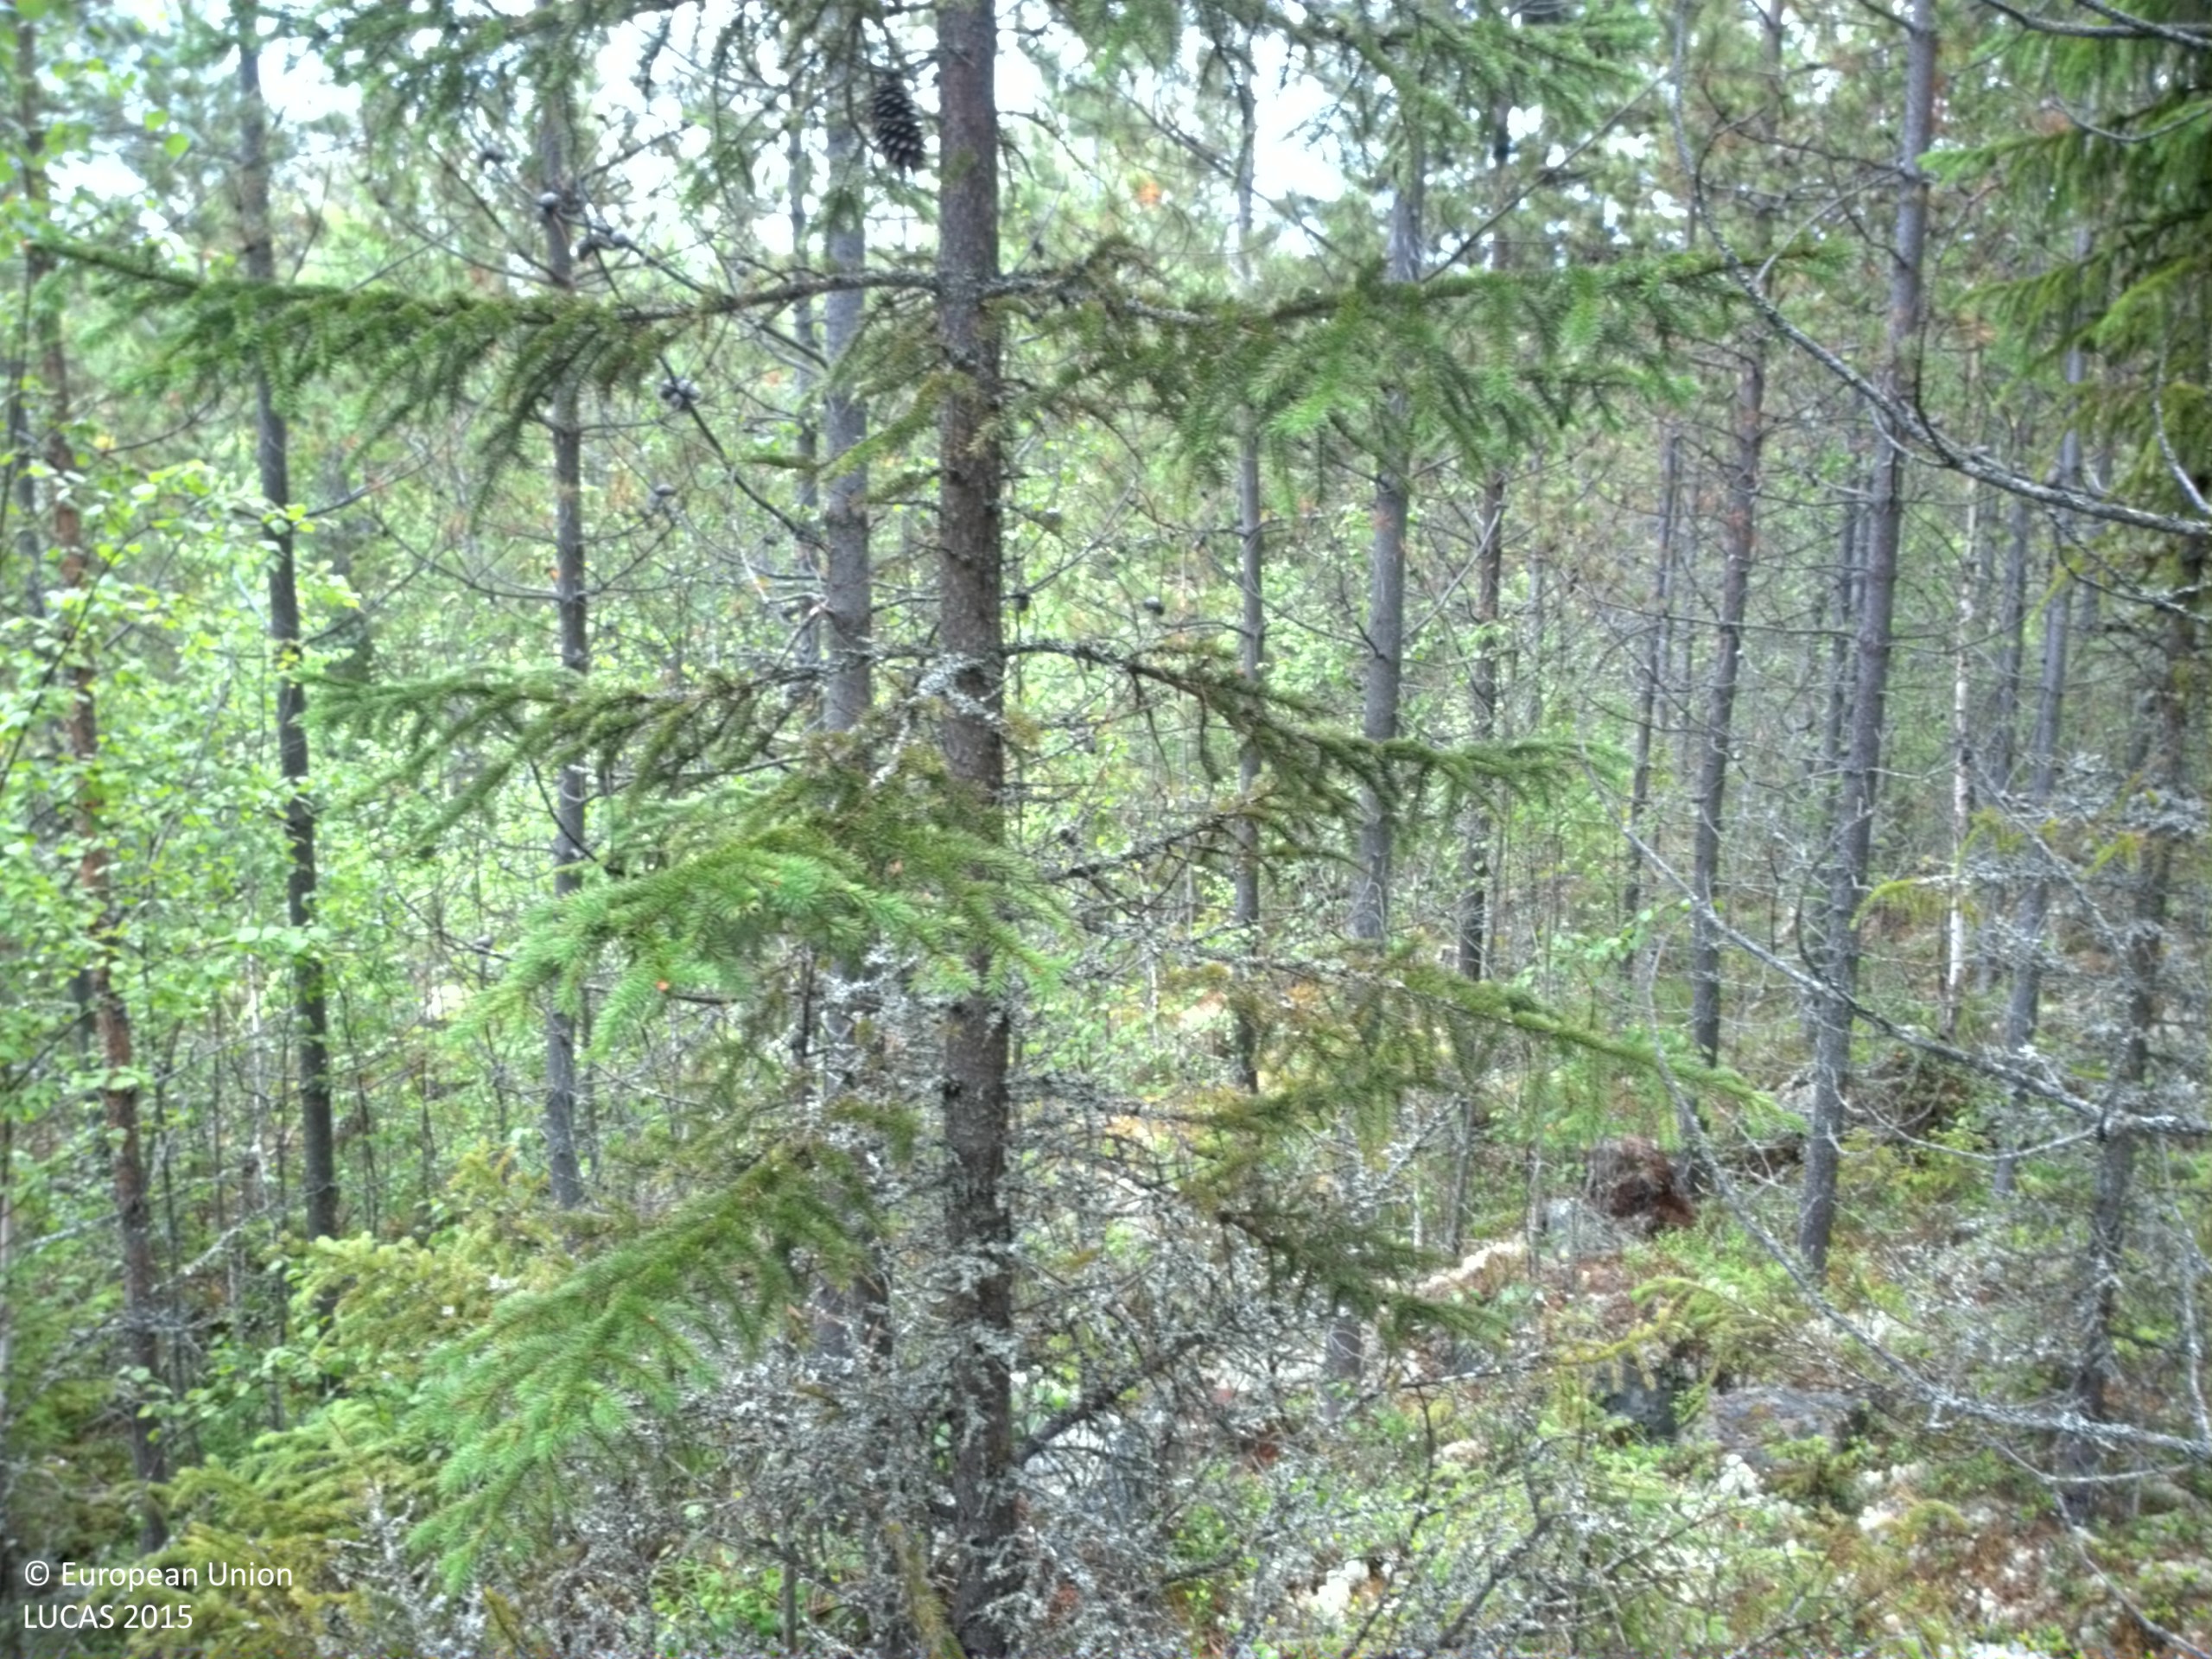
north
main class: Woodland
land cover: Pine dominated coniferous woodland
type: exotic forest
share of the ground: > 75 %
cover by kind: coniferous forest trees 80 %, consolidated bare surface 20 %
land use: Forestry
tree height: > 5 m
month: July
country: SE
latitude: 63.2482
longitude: 17.7220
